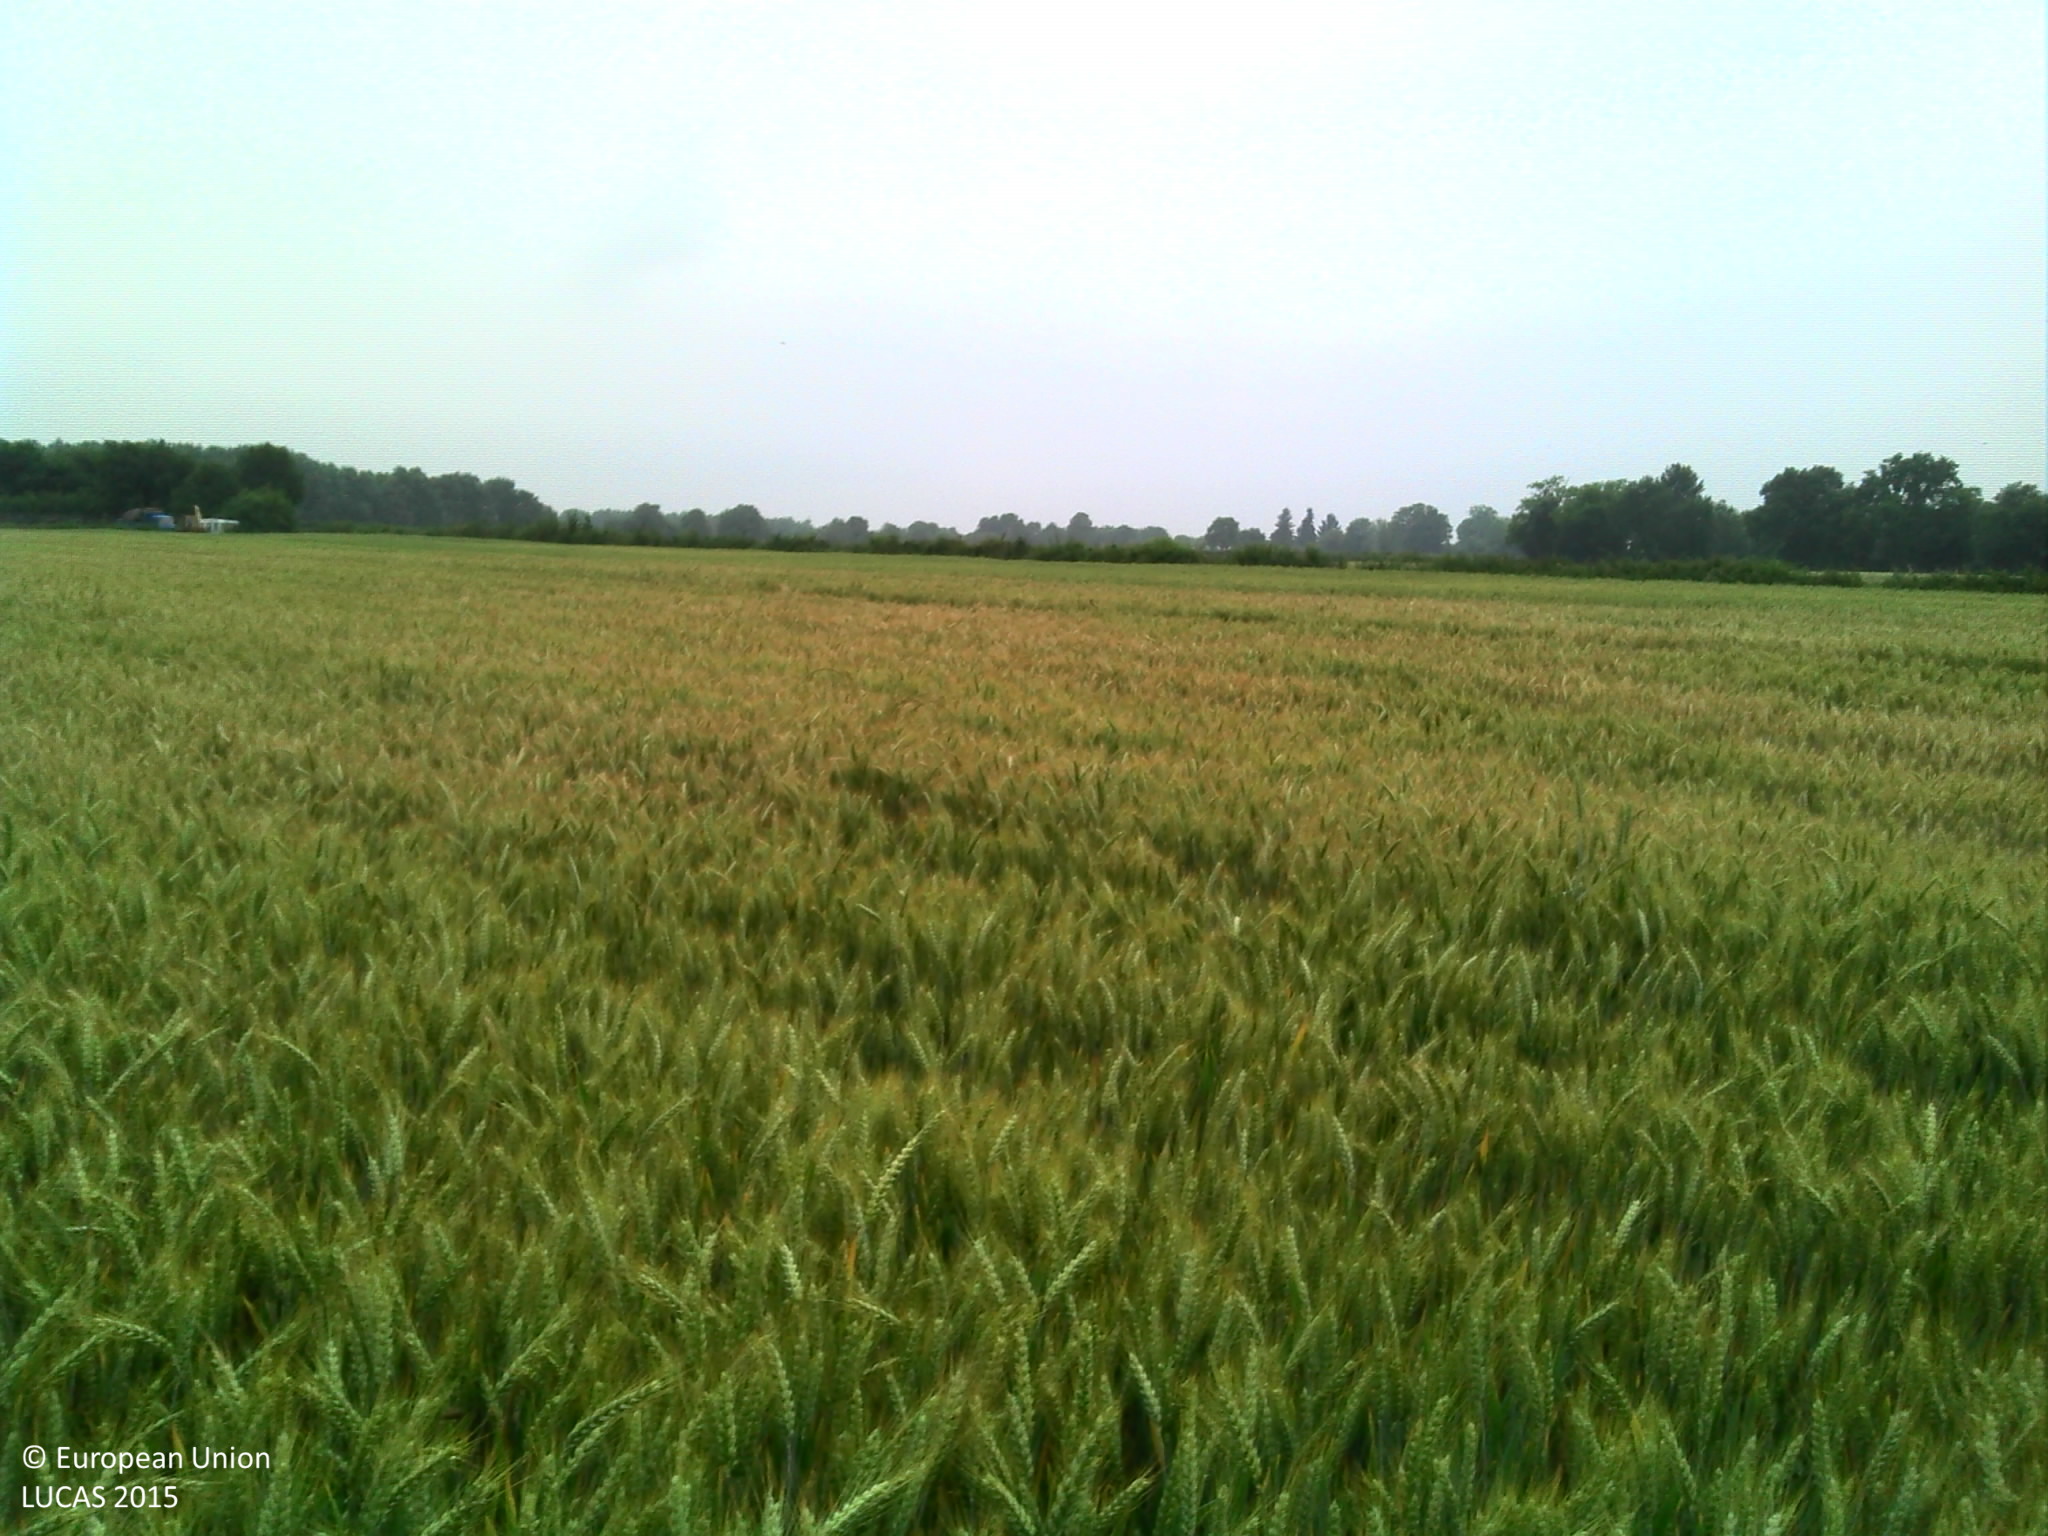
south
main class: Cropland
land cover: Common wheat
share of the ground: > 75 %
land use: Agriculture (excluding fallow land and kitchen gardens)
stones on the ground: < 10 %
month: June
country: FR
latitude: 47.5547
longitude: 2.5369
